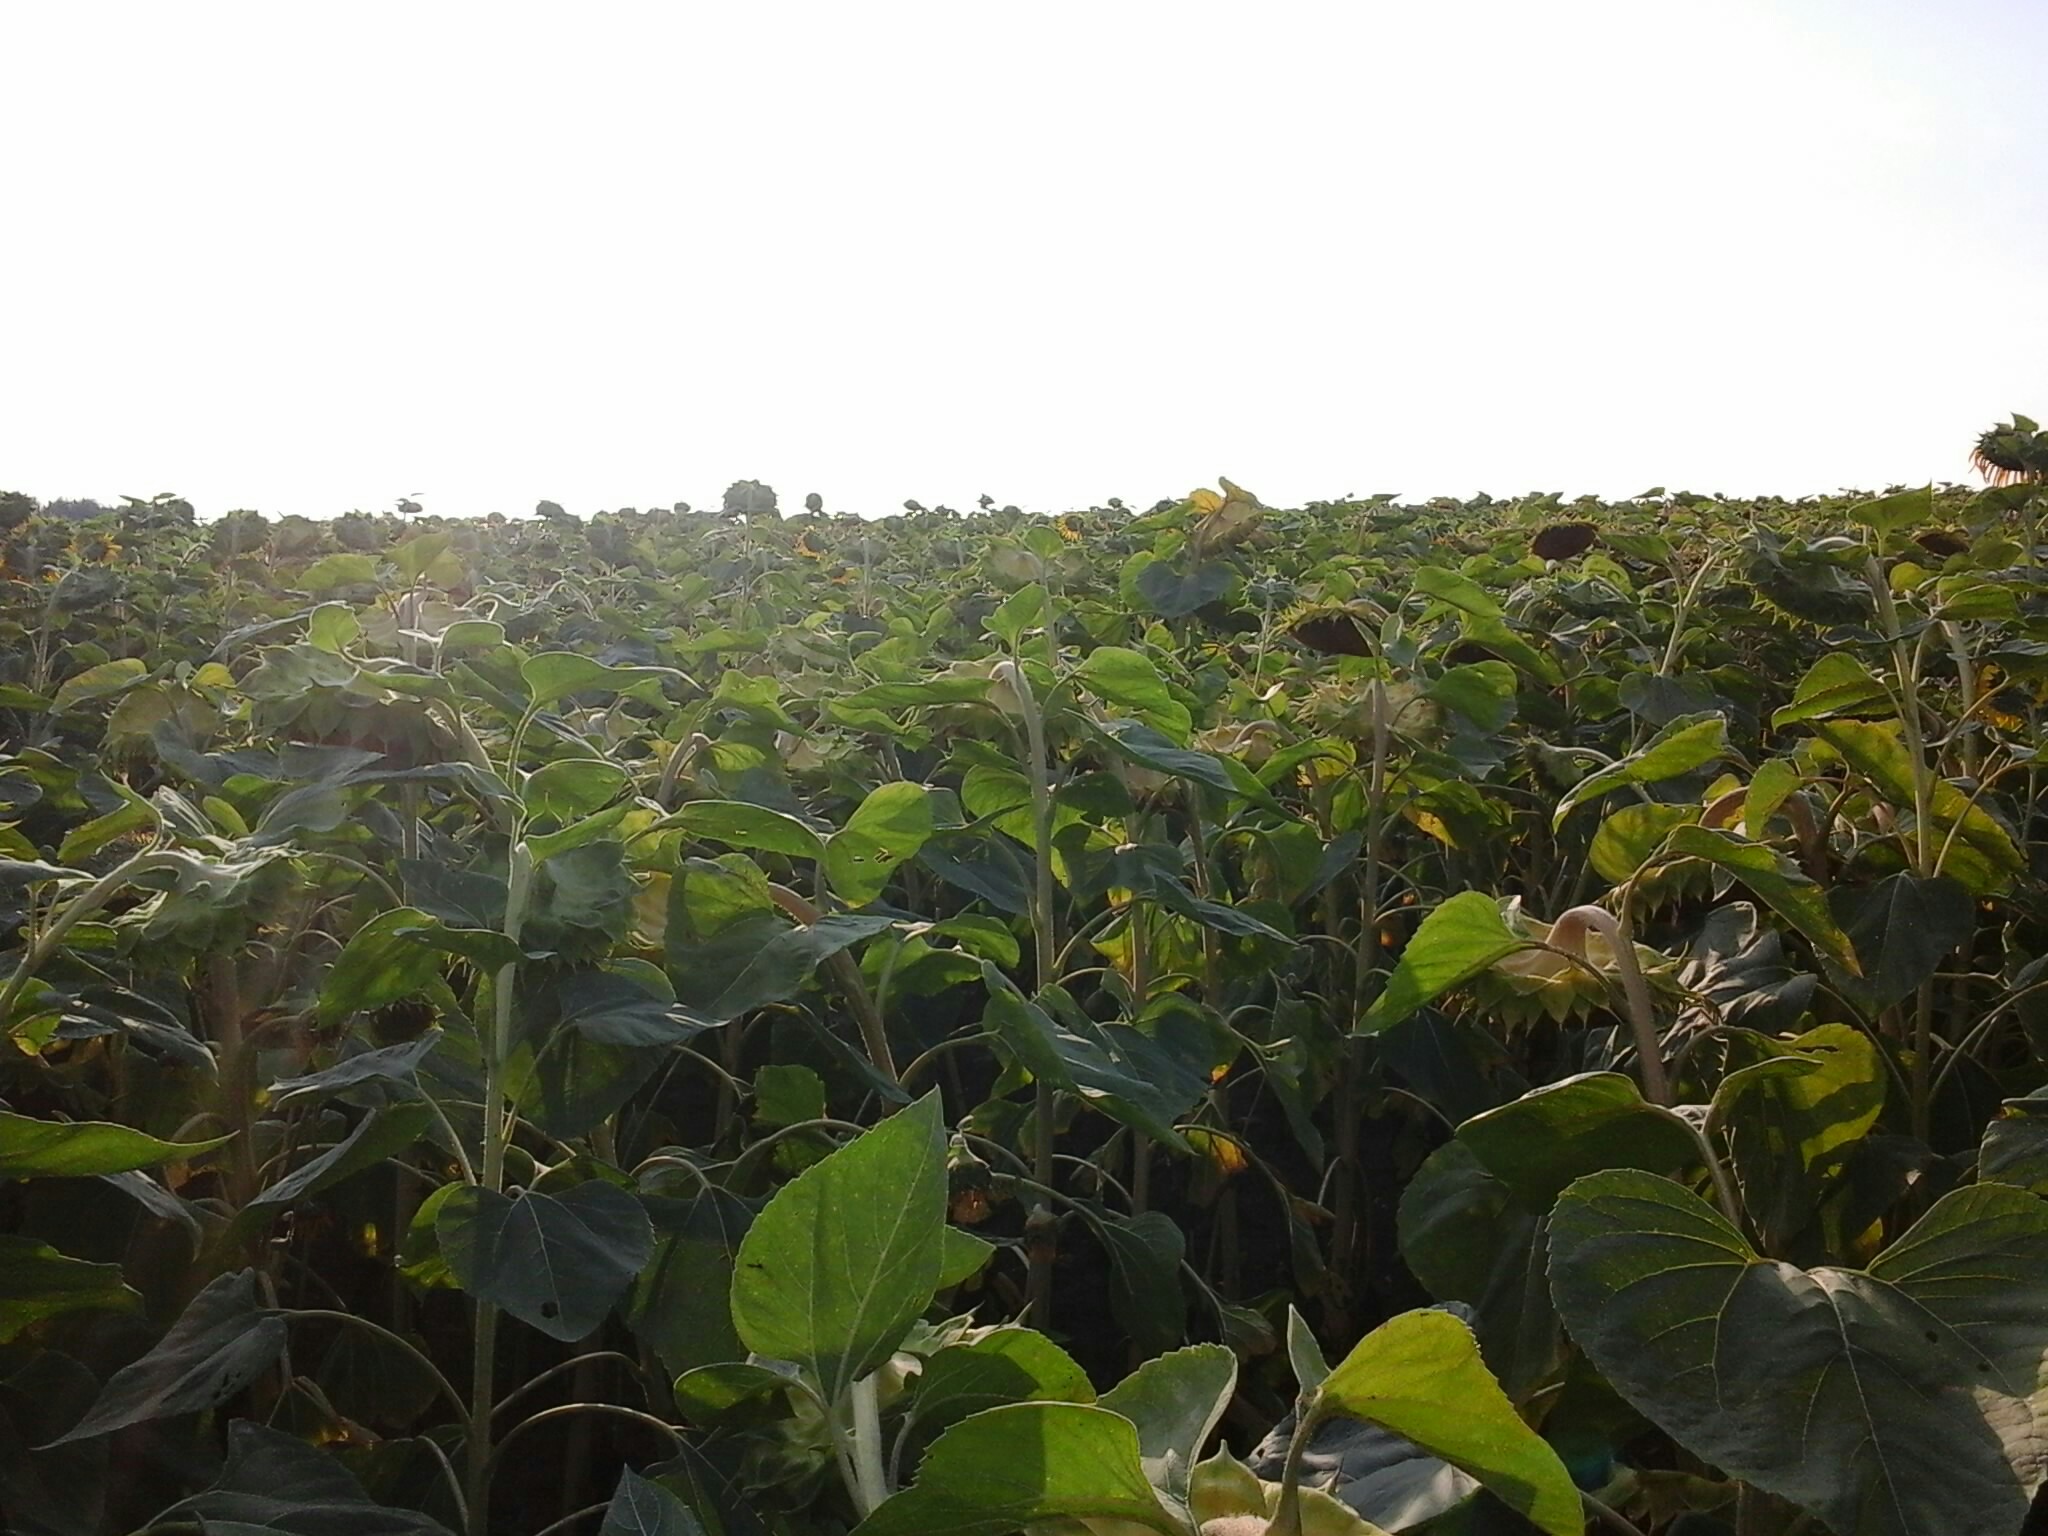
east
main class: Cropland
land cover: Sunflower
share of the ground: > 75 %
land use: Agriculture (excluding fallow land and kitchen gardens)
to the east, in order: Sunflower
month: August
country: HU
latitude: 47.5191
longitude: 17.9653
